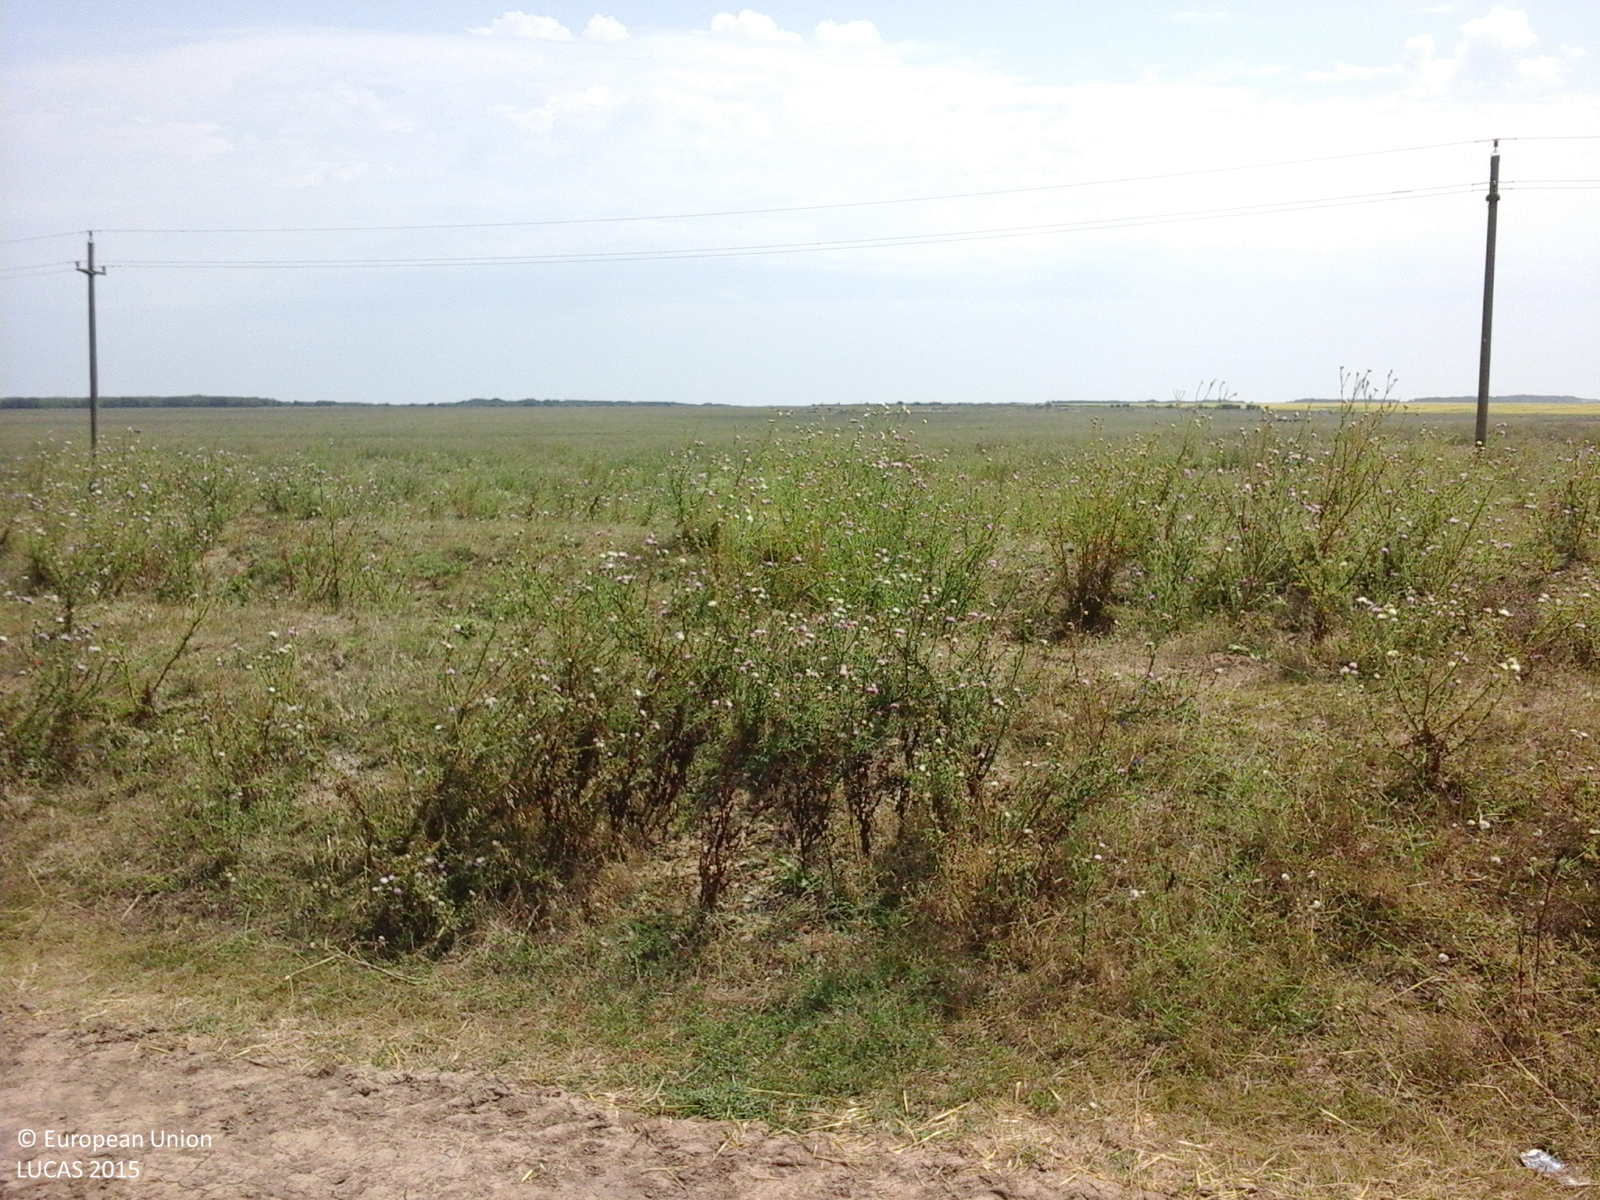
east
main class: Cropland
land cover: Sunflower
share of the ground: > 75 %
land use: Agriculture (excluding fallow land and kitchen gardens)
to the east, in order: Sunflower; Grass margins; Tracks; Grass margins; Ditches and canals; Grassland without tree/shrub cover; Electric lines; Grassland without tree/shrub cover
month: August
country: RO
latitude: 43.9447
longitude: 28.3913
